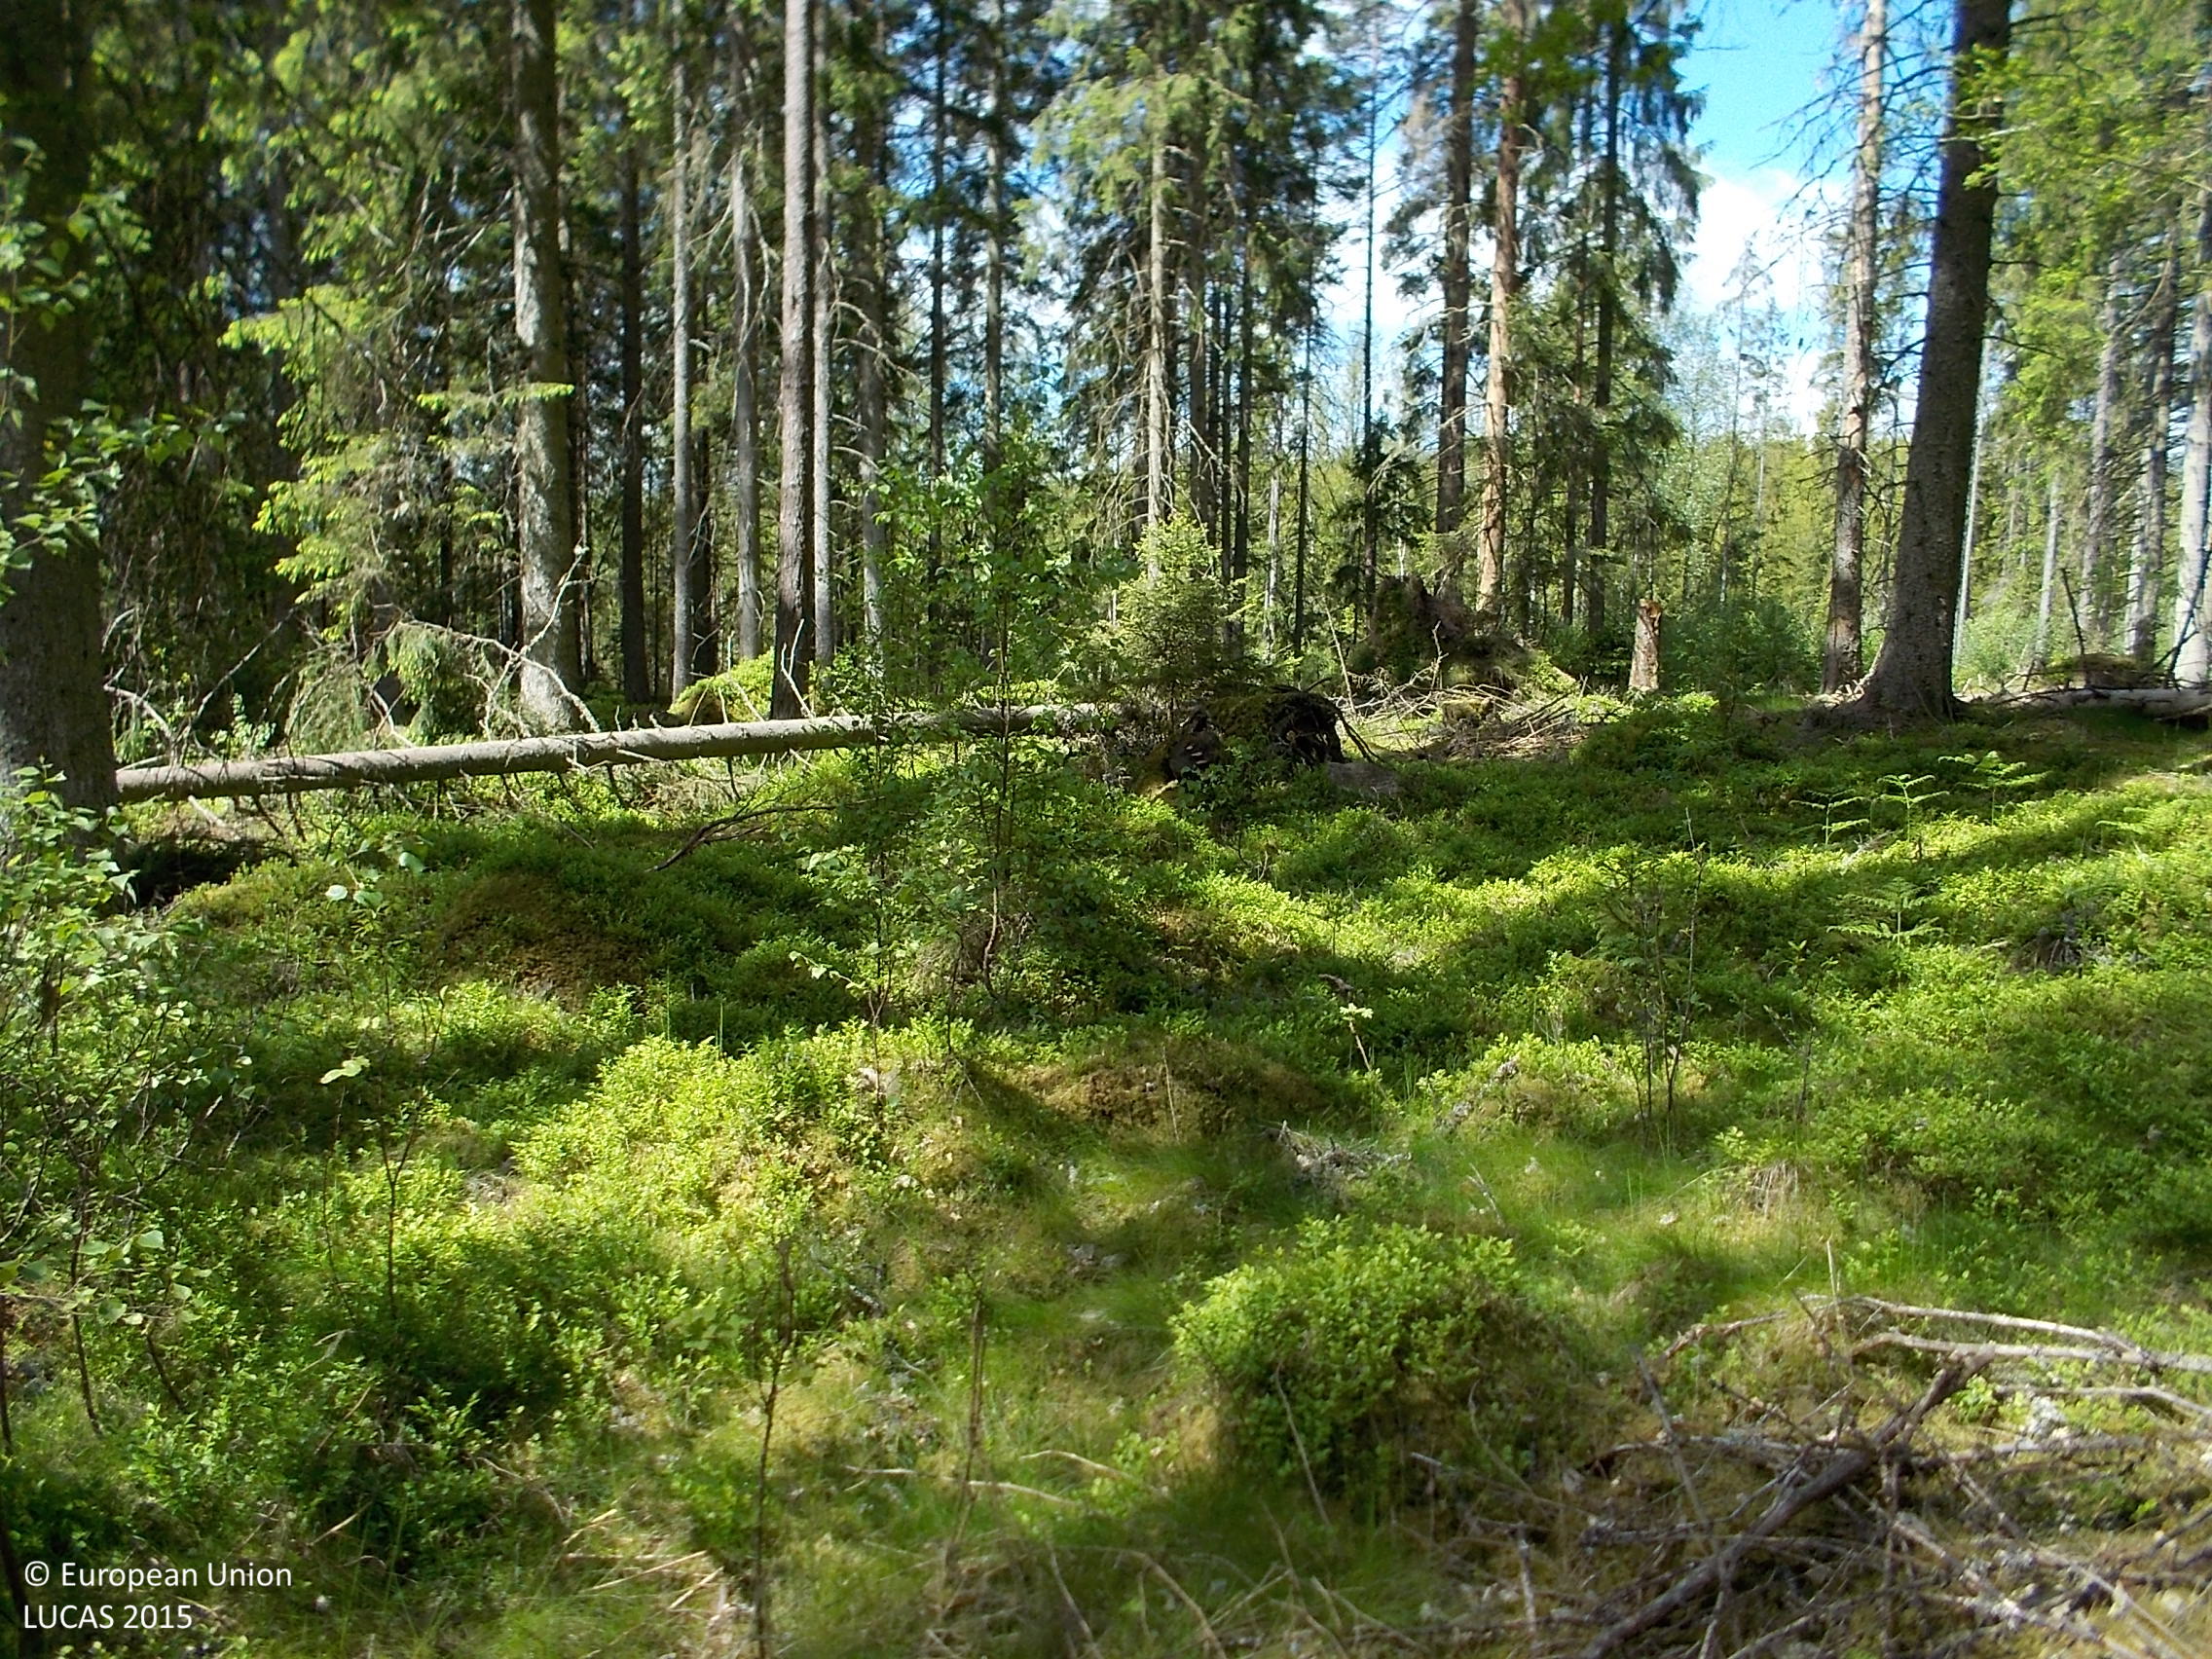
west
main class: Woodland
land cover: Spruce dominated coniferous woodland
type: boreal forest
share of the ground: 50 - 75 %
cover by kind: coniferous forest trees 70 %, shrubs 10 %, lichens and mosses 10 %, broadleaved forest trees 5 %, herbaceous plants 5 %
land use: Forestry
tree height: > 5 m
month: June
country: SE
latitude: 57.6759
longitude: 13.2652
